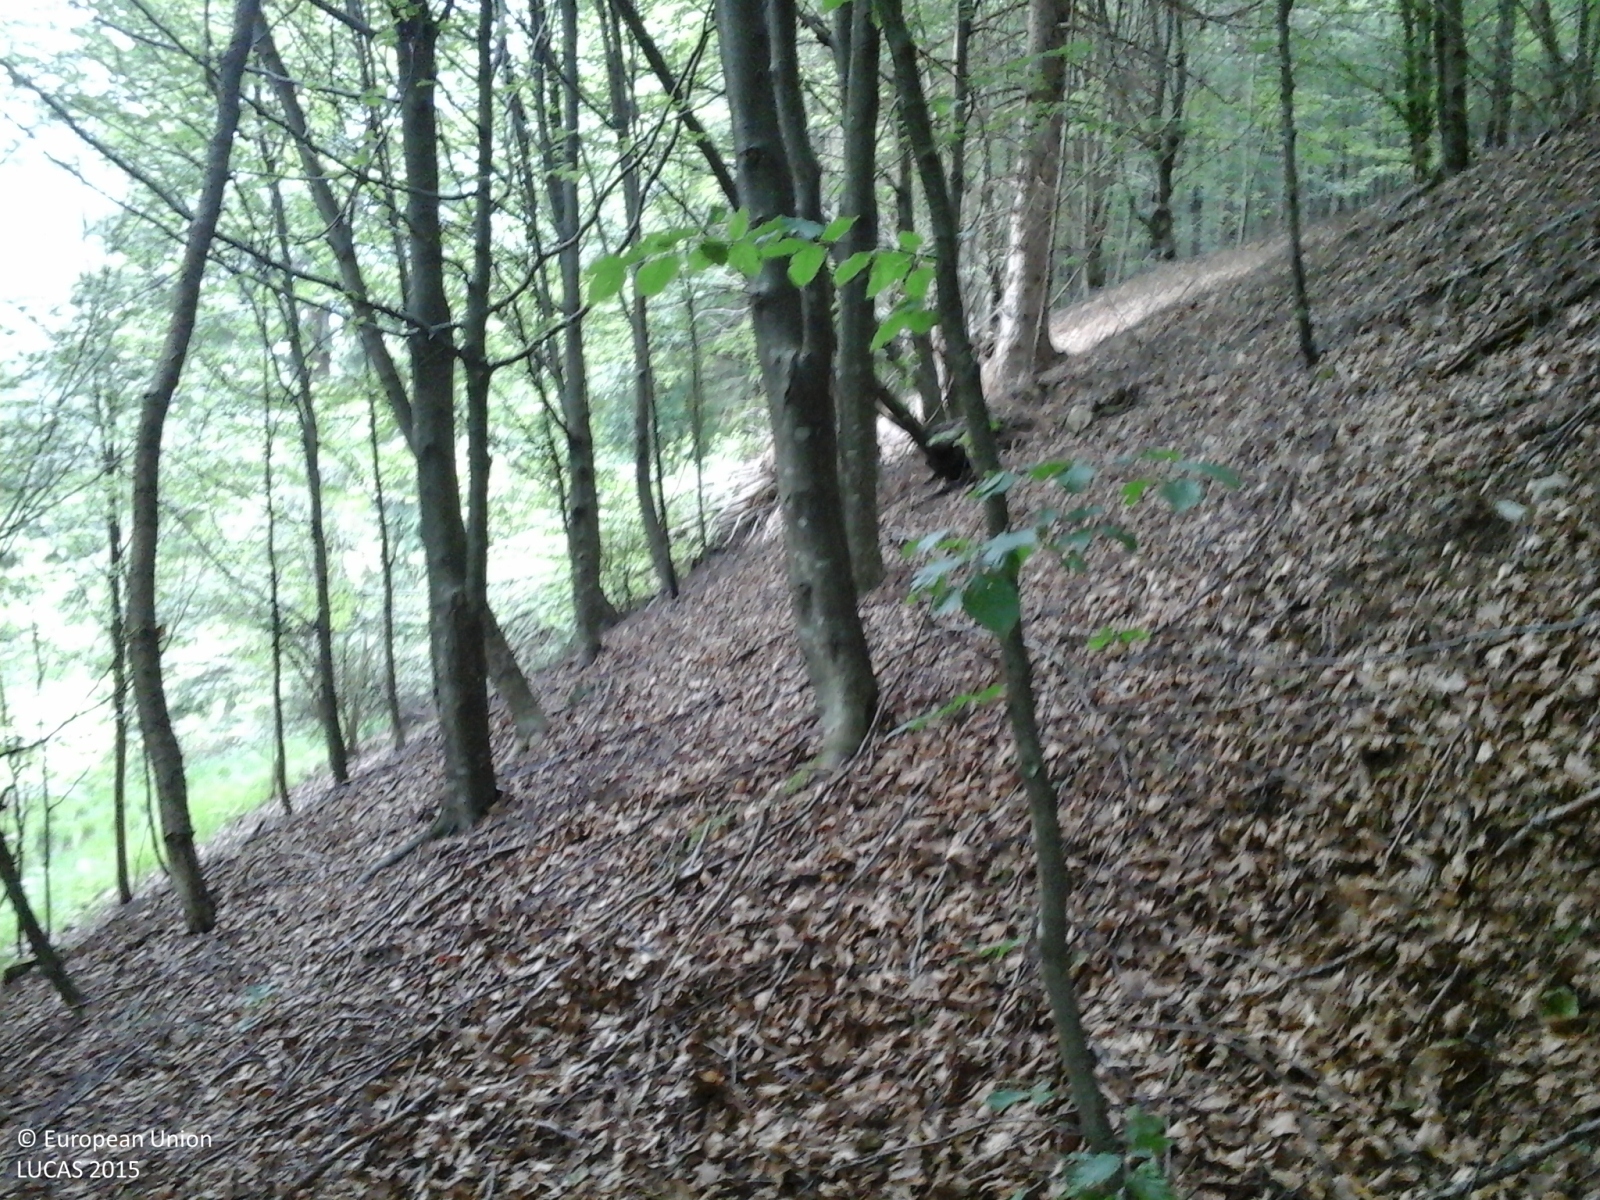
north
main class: Woodland
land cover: Broadleaved woodland
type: mountainous beech forest
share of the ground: > 75 %
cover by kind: broadleaved forest trees 95 %, coniferous forest trees 5 %
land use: Forestry
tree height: > 5 m
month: June
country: IT
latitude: 46.1797
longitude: 12.4195
